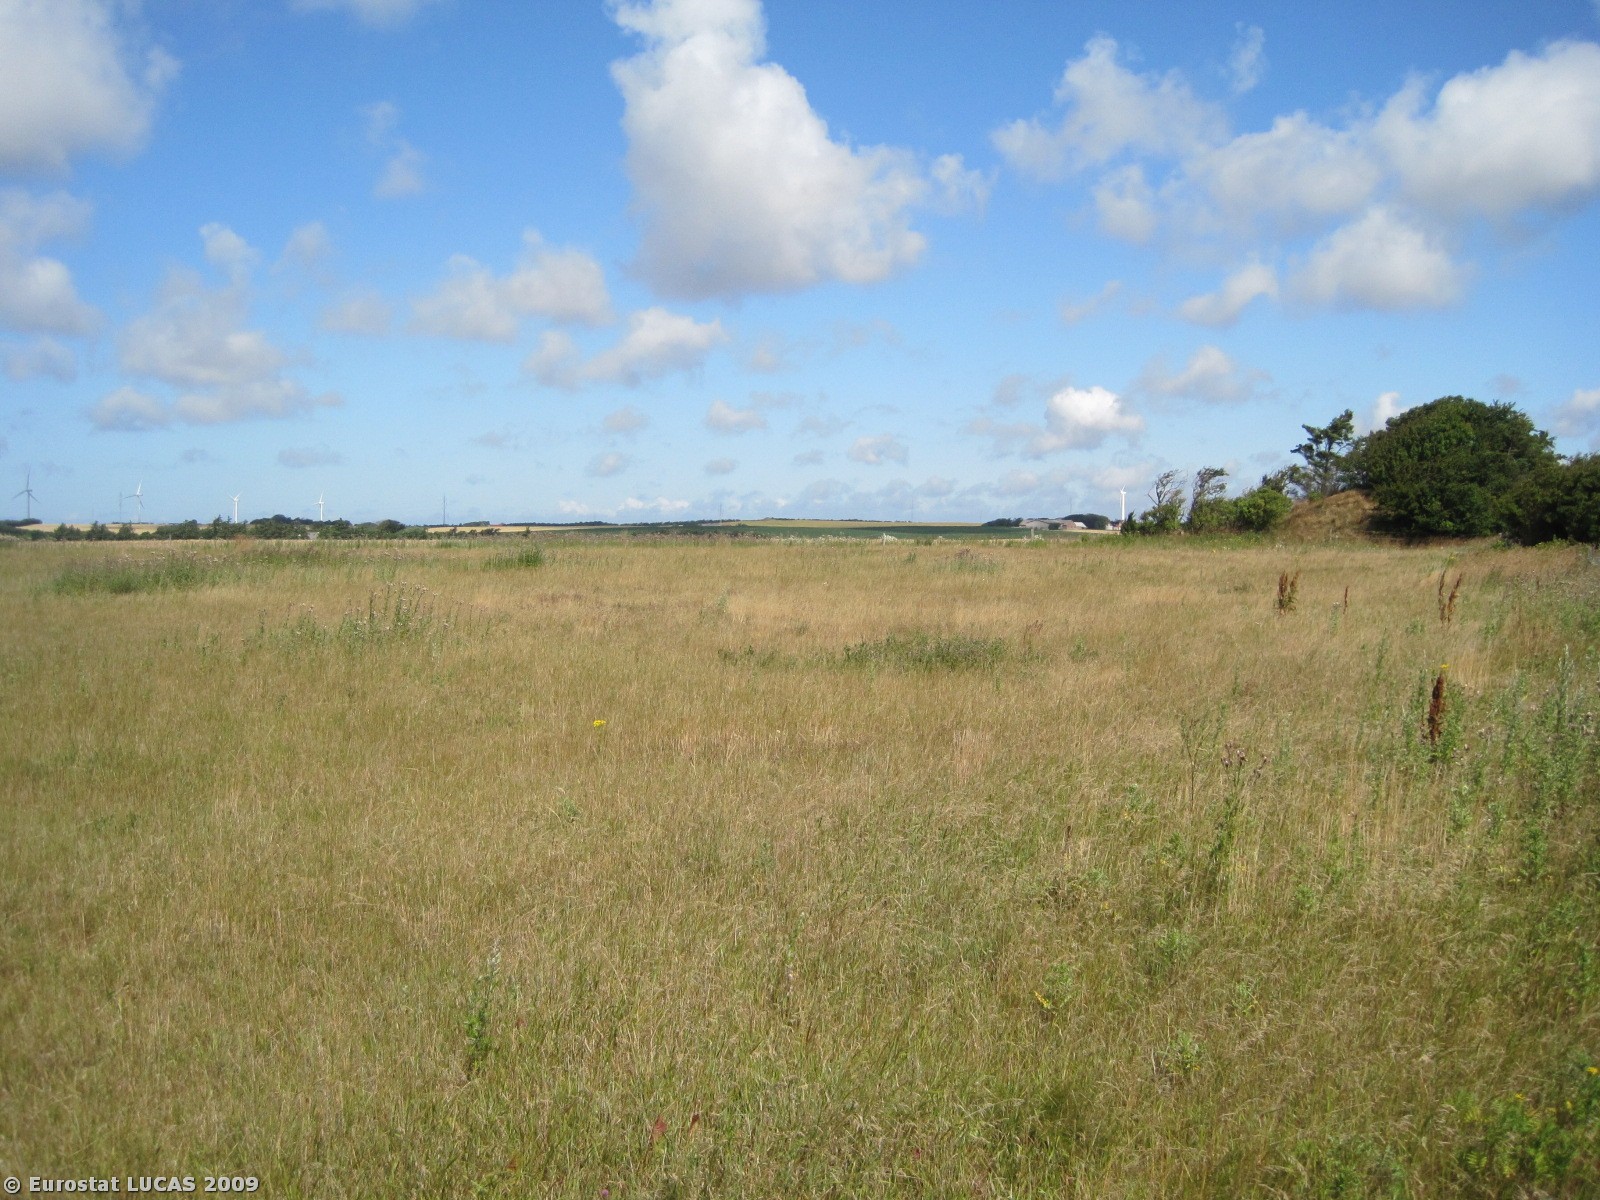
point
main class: Grassland
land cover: Grassland without tree/shrub cover
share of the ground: > 75 %
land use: Agriculture (excluding fallow land and kitchen gardens)
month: July
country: DK
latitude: 56.7174
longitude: 8.4172
